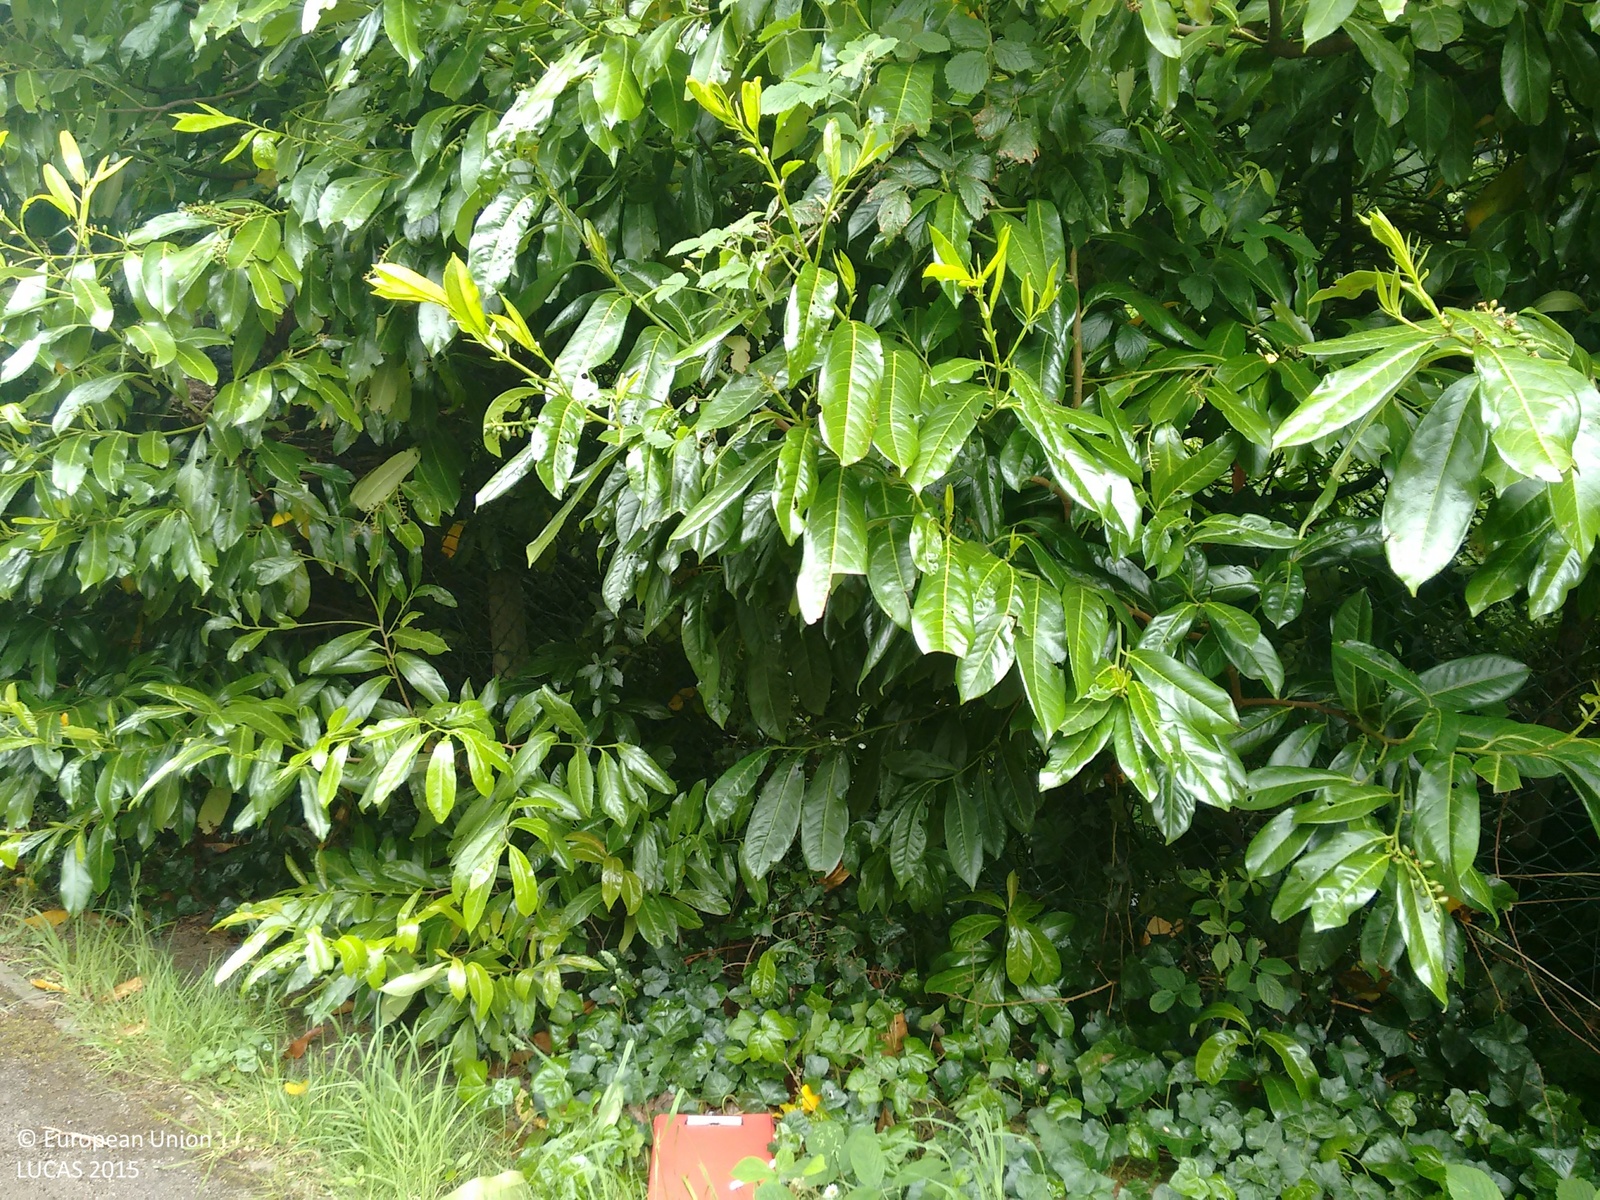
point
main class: Woodland
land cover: Broadleaved woodland
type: mesophytic deciduous forest
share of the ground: > 75 %
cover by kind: broadleaved forest trees 100 %
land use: Community services
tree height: > 5 m
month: June
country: GB
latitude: 54.8724
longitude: -1.8494
